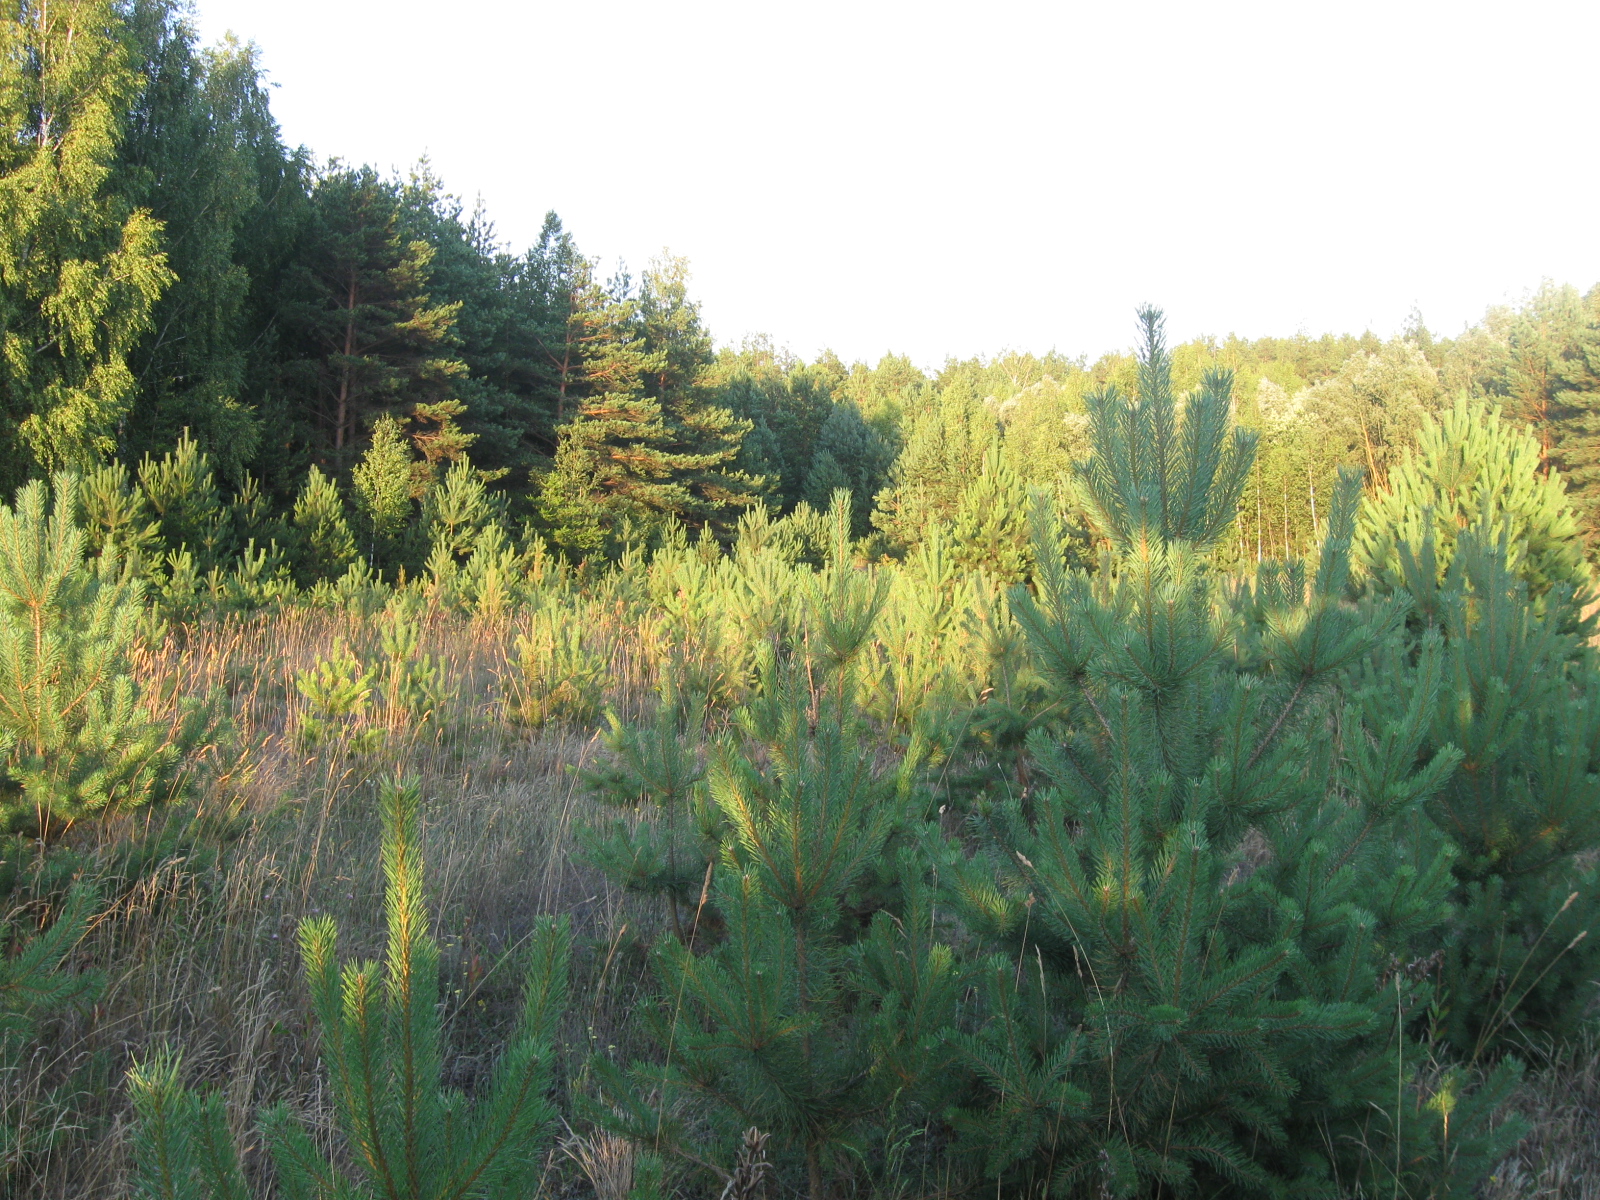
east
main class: Woodland
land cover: Pine dominated coniferous woodland
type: hemiboreal forest and nemoral coniferous forest and mixed broadleaved-coniferous forest
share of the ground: 25 - 50 %
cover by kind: herbaceous plants 55 %, coniferous forest trees 45 %
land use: Forestry
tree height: < 5 m
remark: Nursery
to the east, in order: Pine dominated coniferous woodland; Tracks; Pine dominated coniferous woodland; Tracks; Pine dominated coniferous woodland; Pine dominated mixed woodland
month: July
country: LT
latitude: 54.0956
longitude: 23.7110
